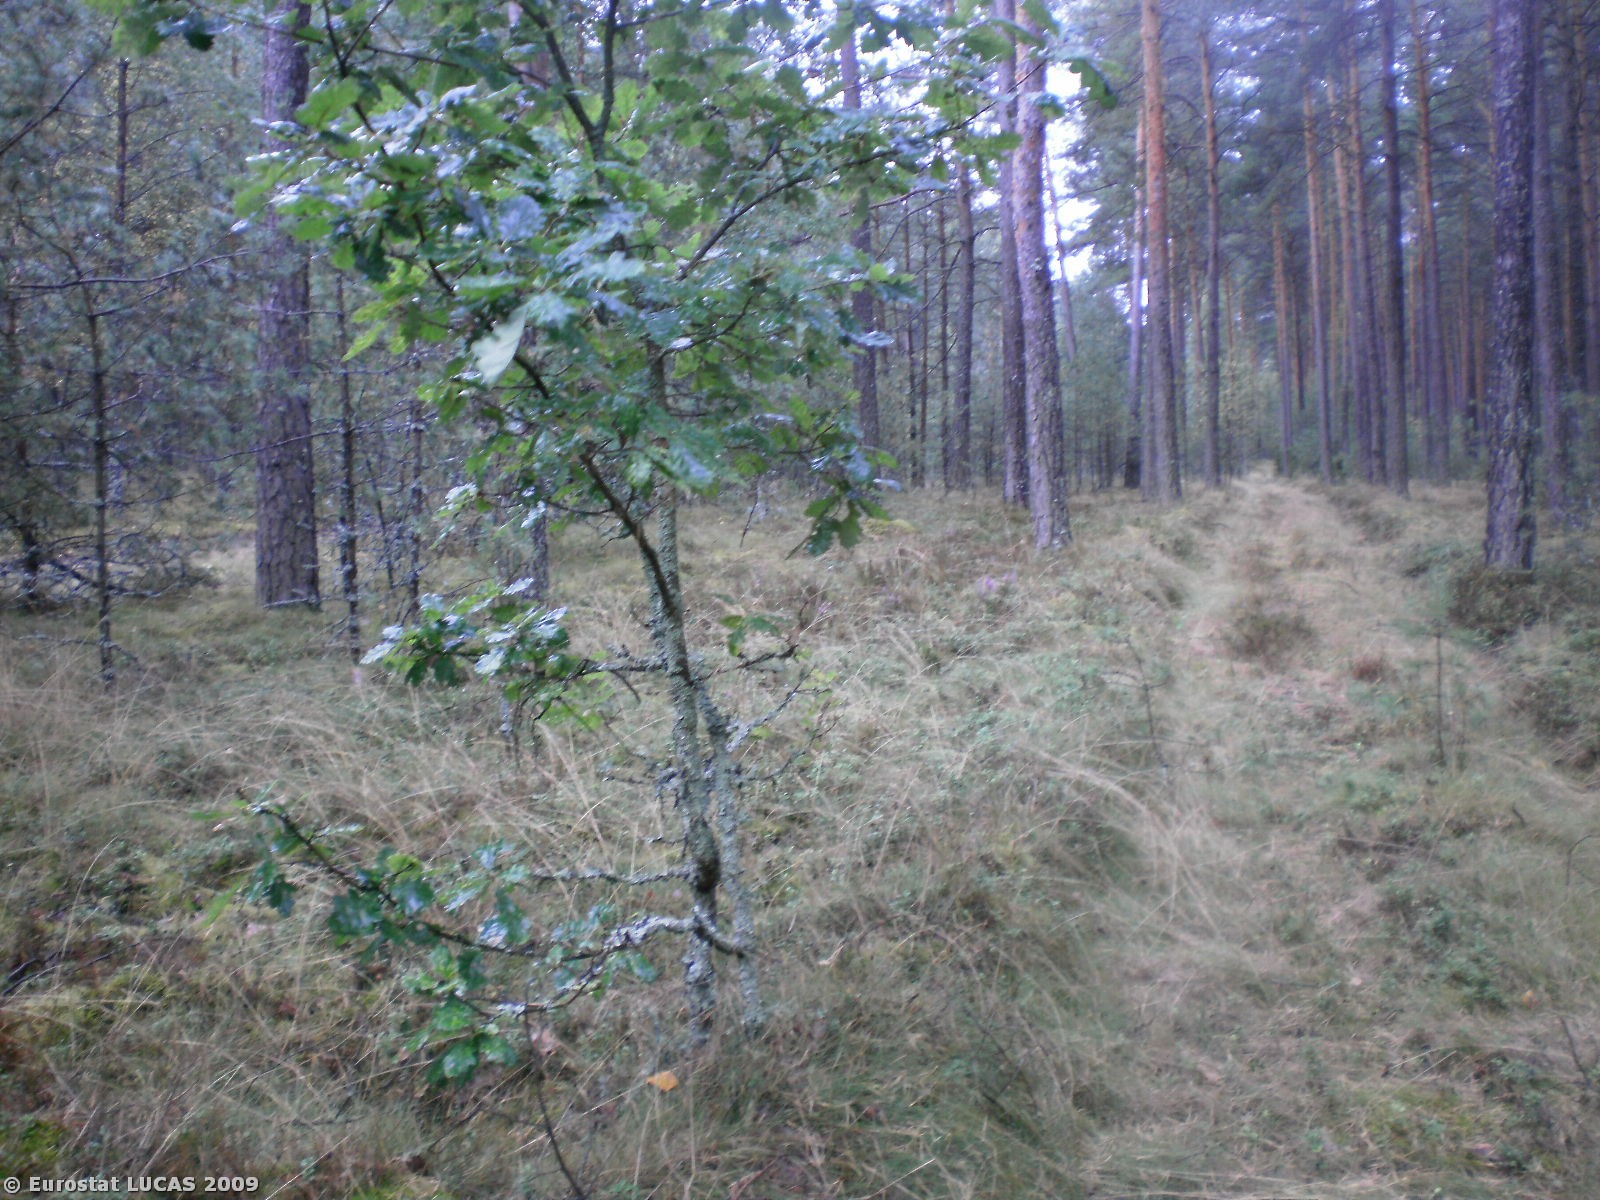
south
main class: Woodland
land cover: Coniferous woodland
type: hemiboreal forest and nemoral coniferous forest and mixed broadleaved-coniferous forest
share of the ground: 50 - 75 %
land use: Forestry
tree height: > 5 m
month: September
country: PL
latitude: 53.8876
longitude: 17.8489
